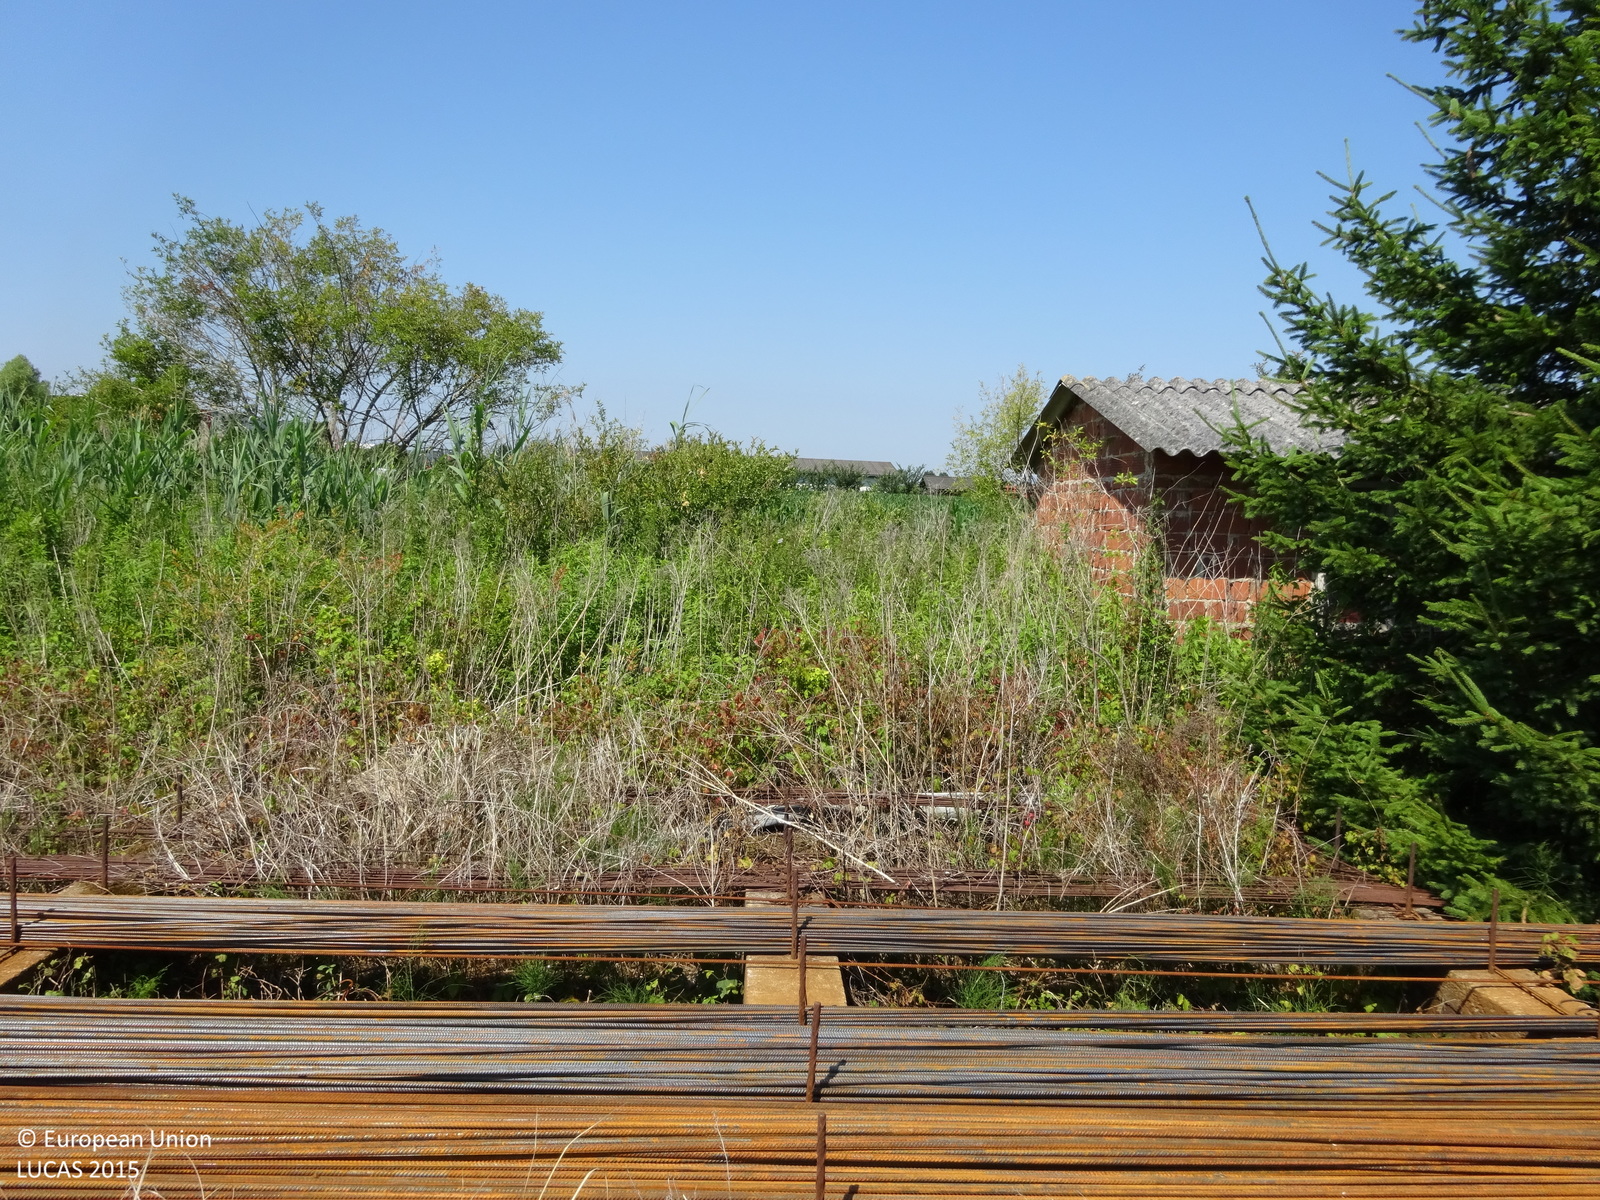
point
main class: Grassland
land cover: Spontaneously vegetated surfaces
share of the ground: 25 - 50 %
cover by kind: herbaceous plants 60 %, consolidated bare surface 20 %, unconsolidated bare surface 20 %
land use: Construction
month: July
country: AT
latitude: 46.9335
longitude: 16.1352
